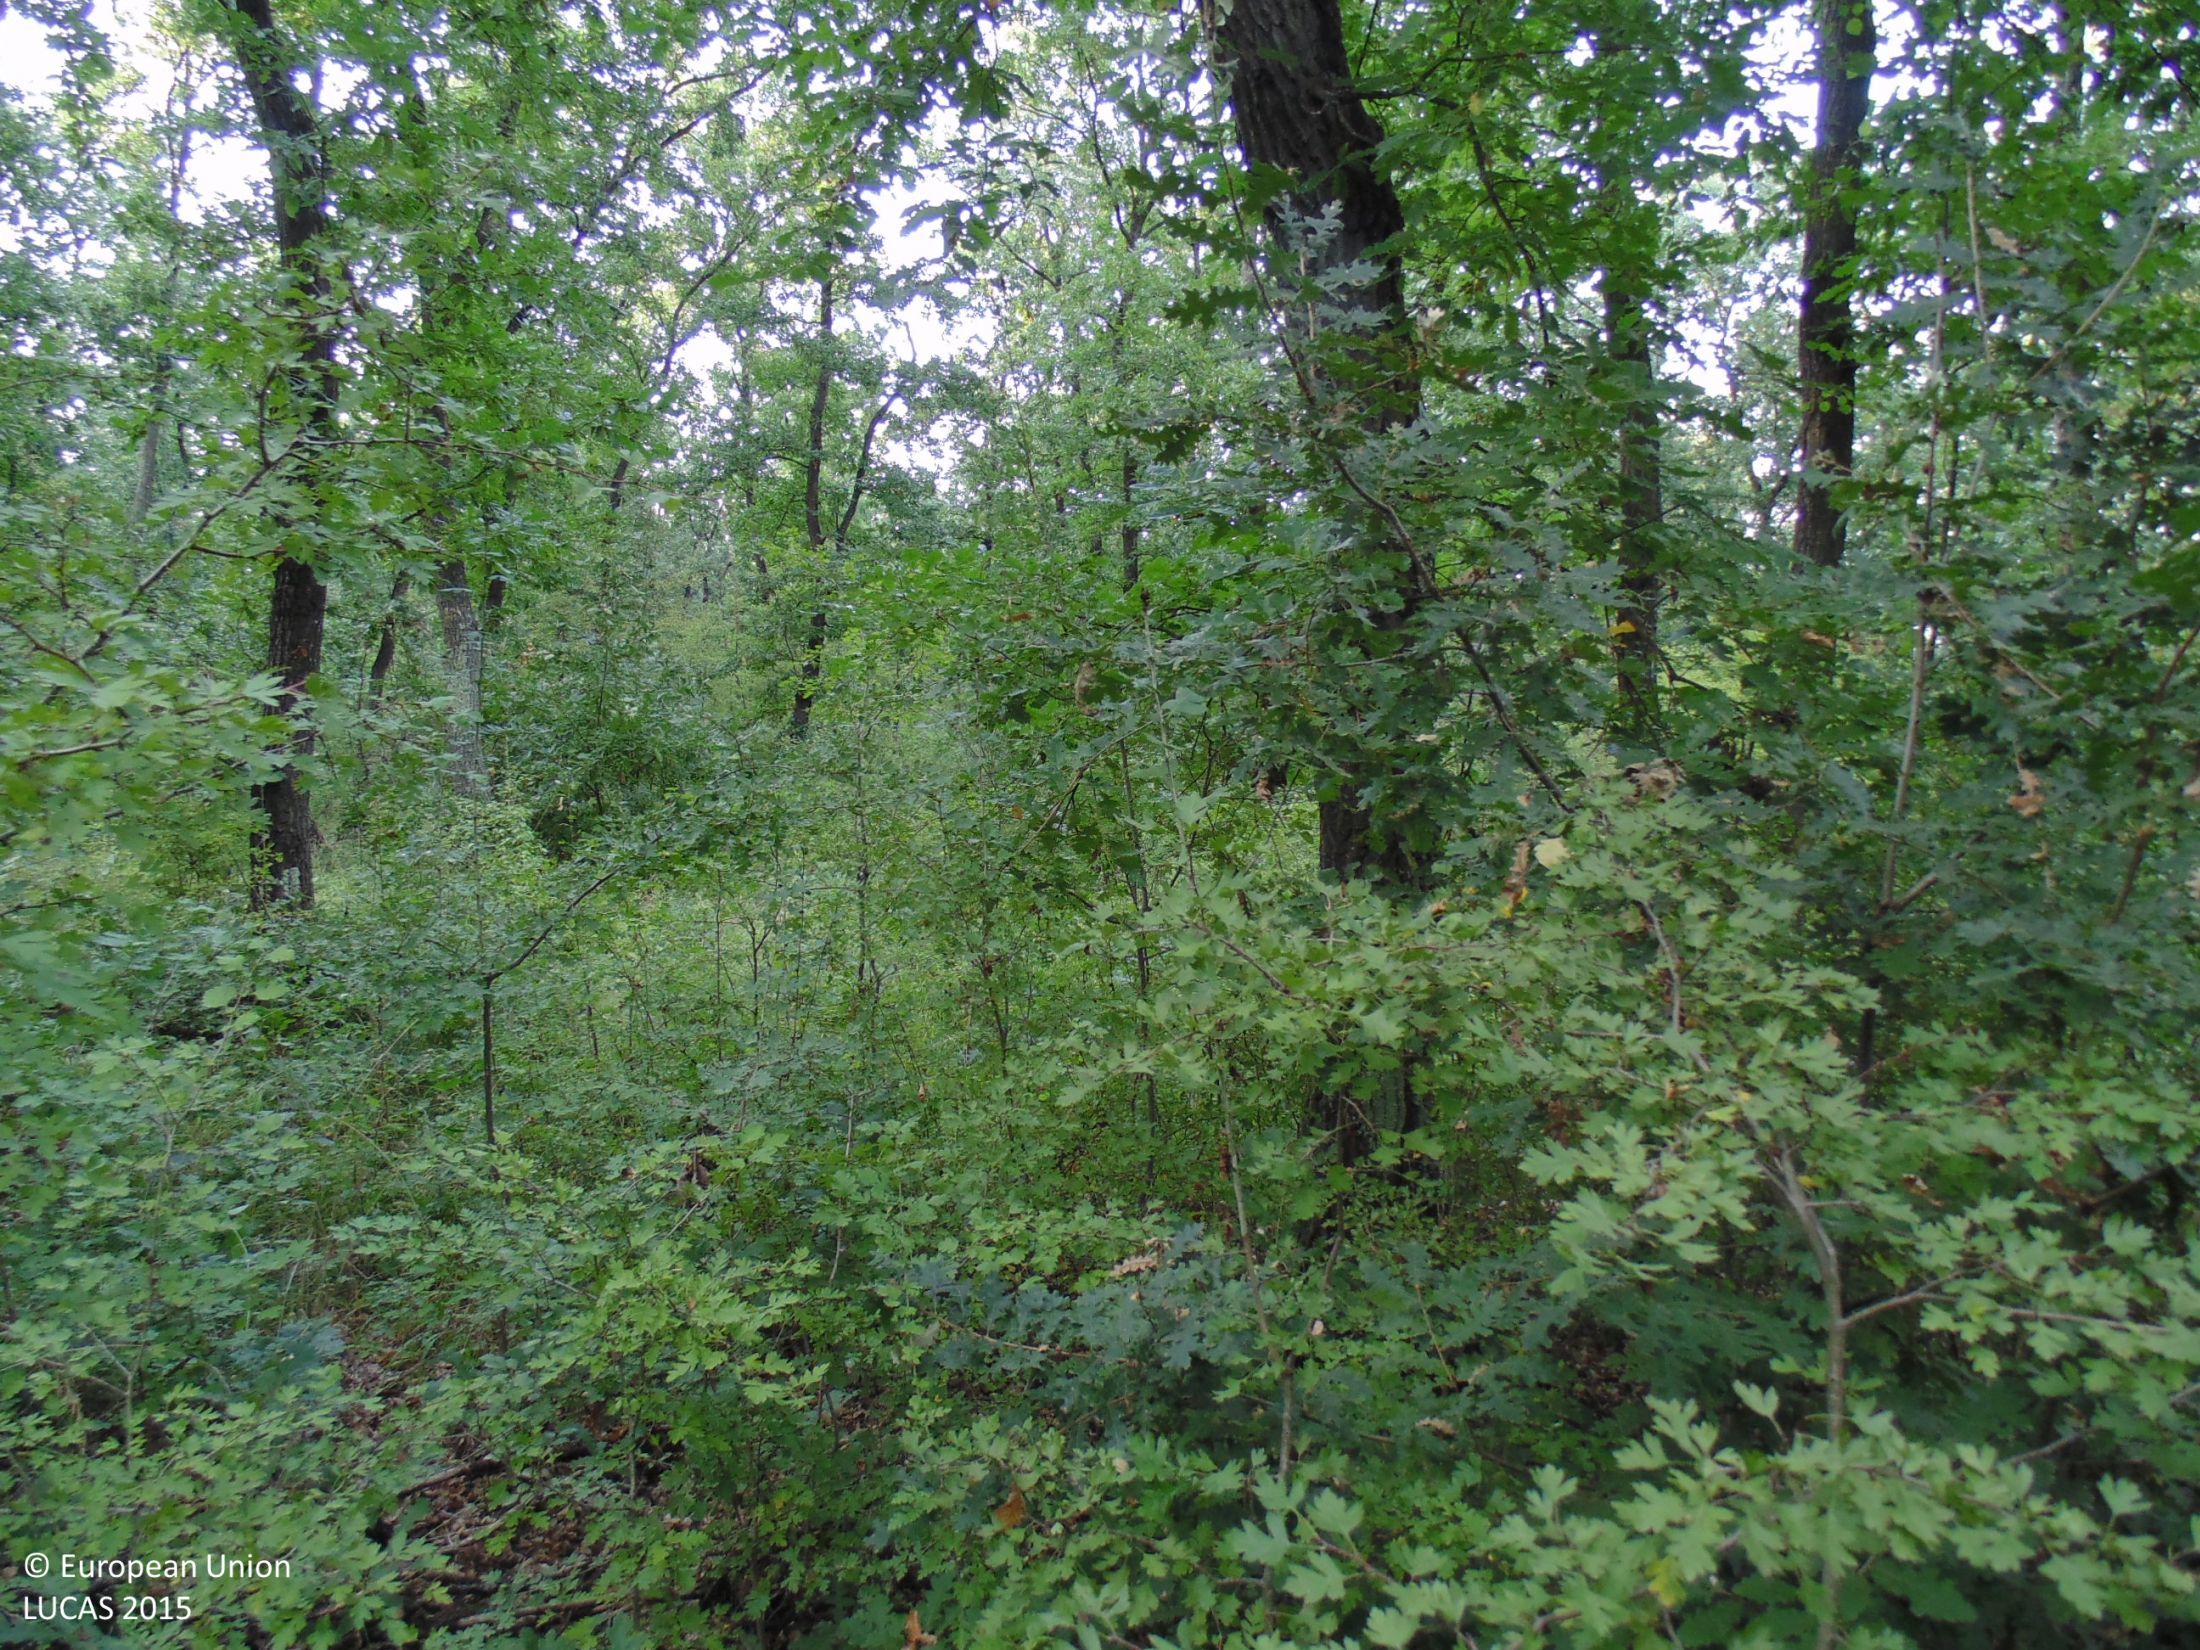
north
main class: Woodland
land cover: Broadleaved woodland
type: mesophytic deciduous forest
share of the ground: > 75 %
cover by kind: broadleaved forest trees 90 %, shrubs 5 %, unconsolidated bare surface 5 %
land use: Forestry
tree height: > 5 m
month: August
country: BG
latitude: 43.8029
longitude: 27.5248
